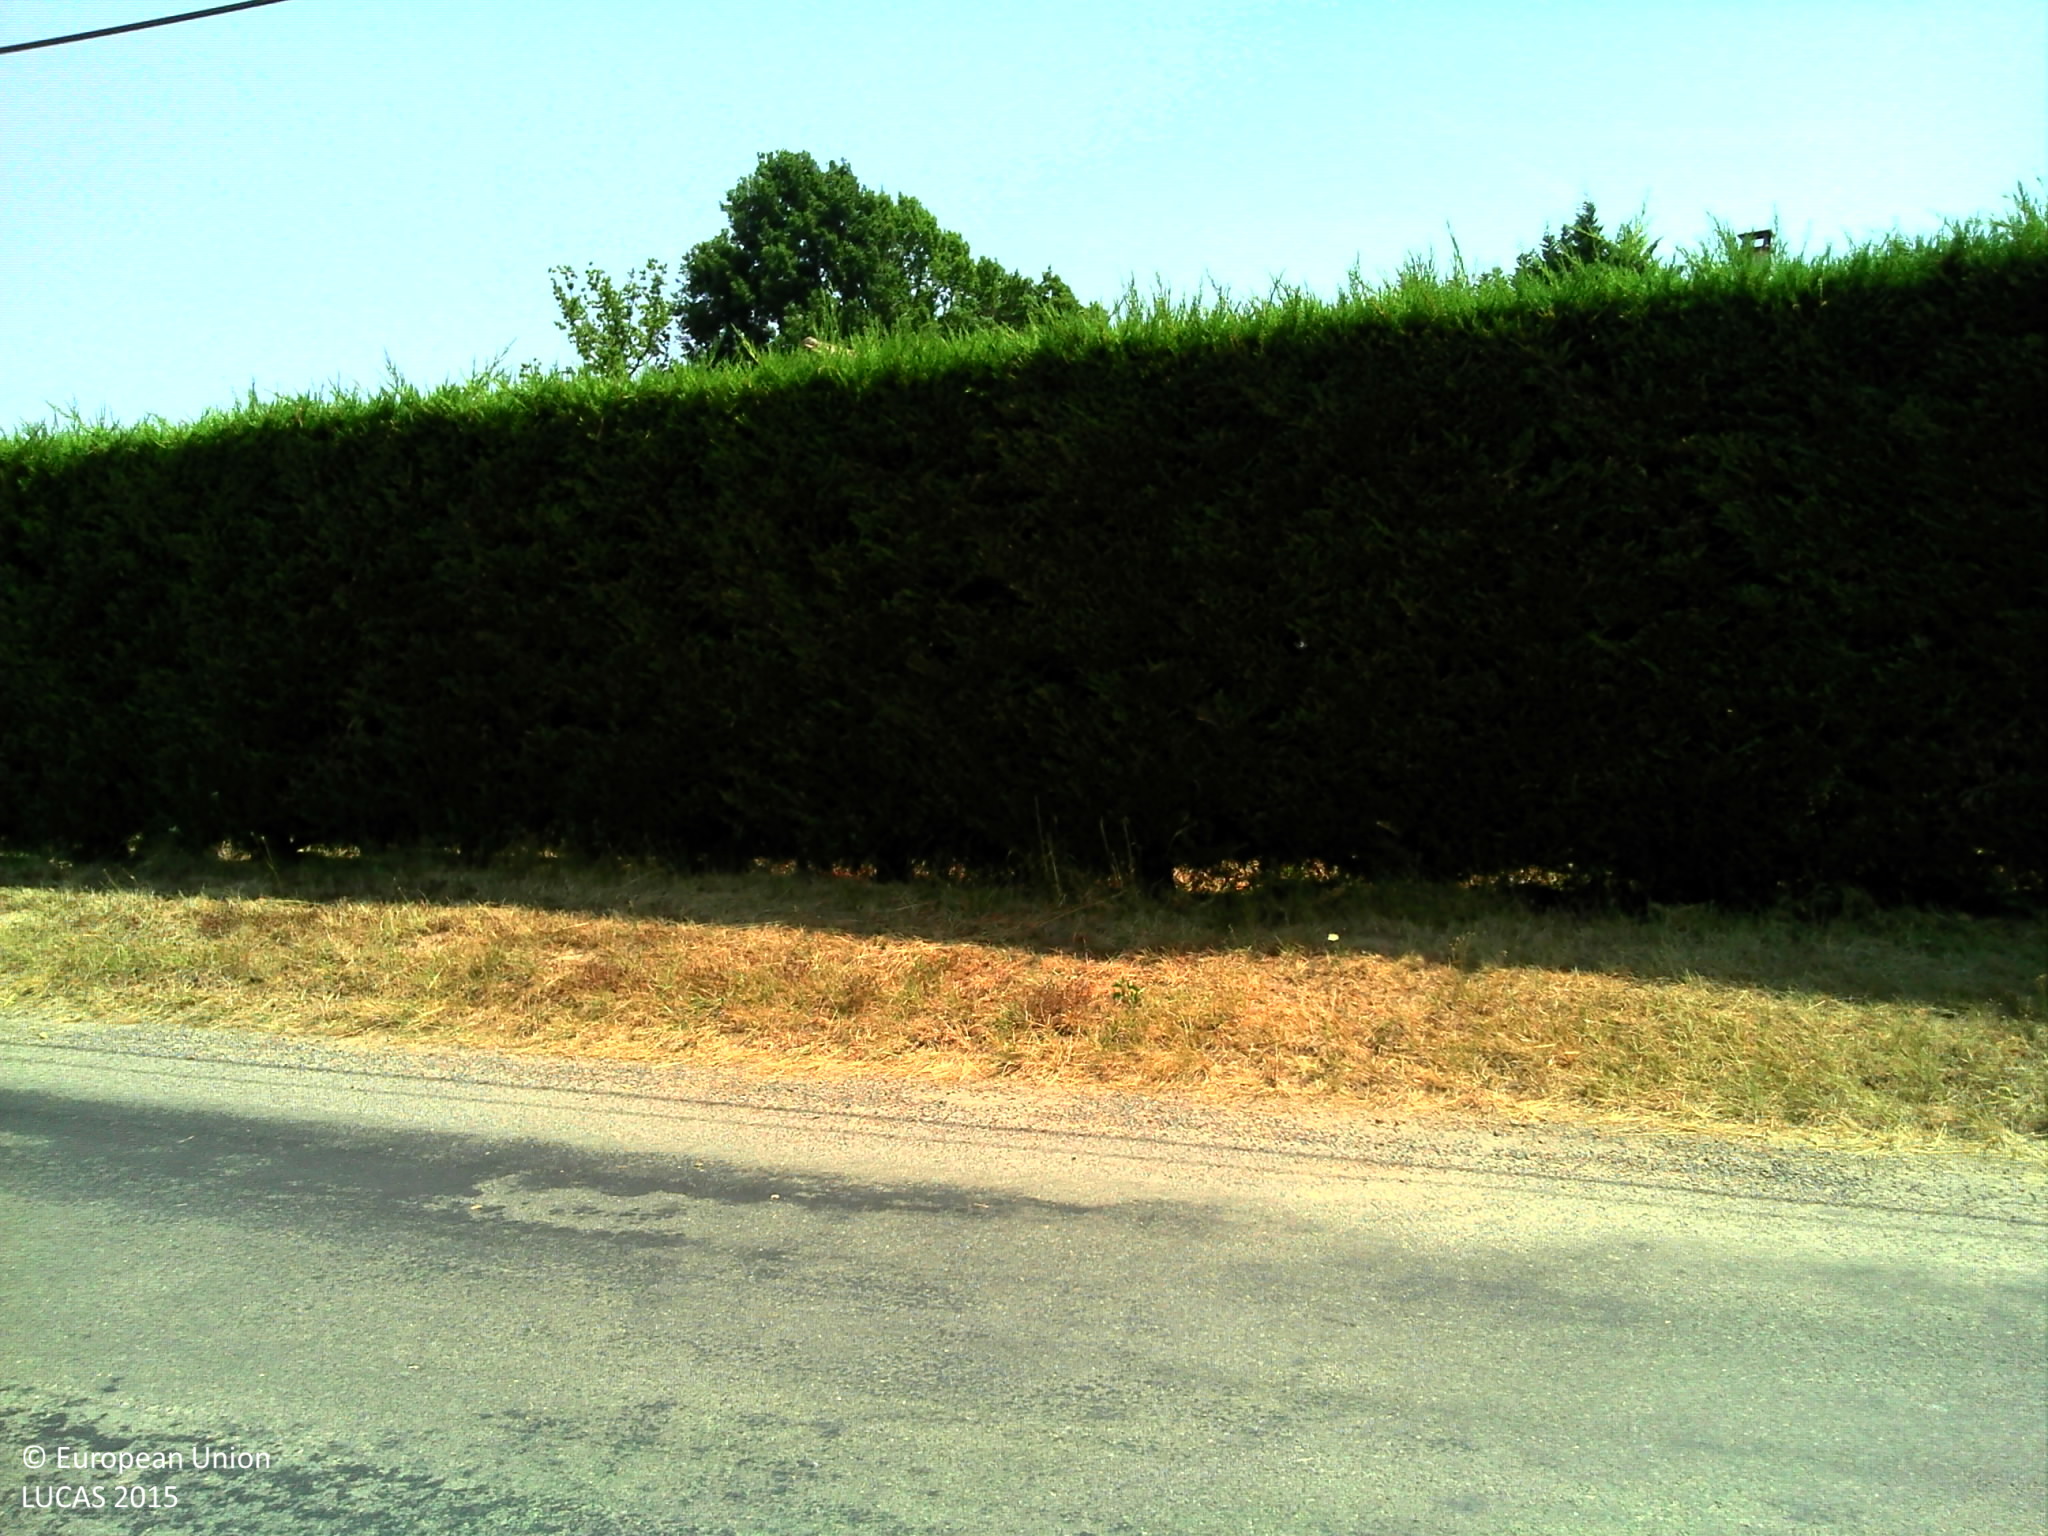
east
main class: Grassland
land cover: Grassland without tree/shrub cover
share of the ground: > 75 %
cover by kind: herbaceous plants 100 %
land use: Agriculture (excluding fallow land and kitchen gardens)
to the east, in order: Grassland without tree/shrub cover; Artificial constructions in urban areas; Broadleaved woodland; Artificial constructions in urban areas; Grassland without tree/shrub cover; Broadleaved woodland
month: July
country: FR
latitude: 45.1179
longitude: 0.7747
